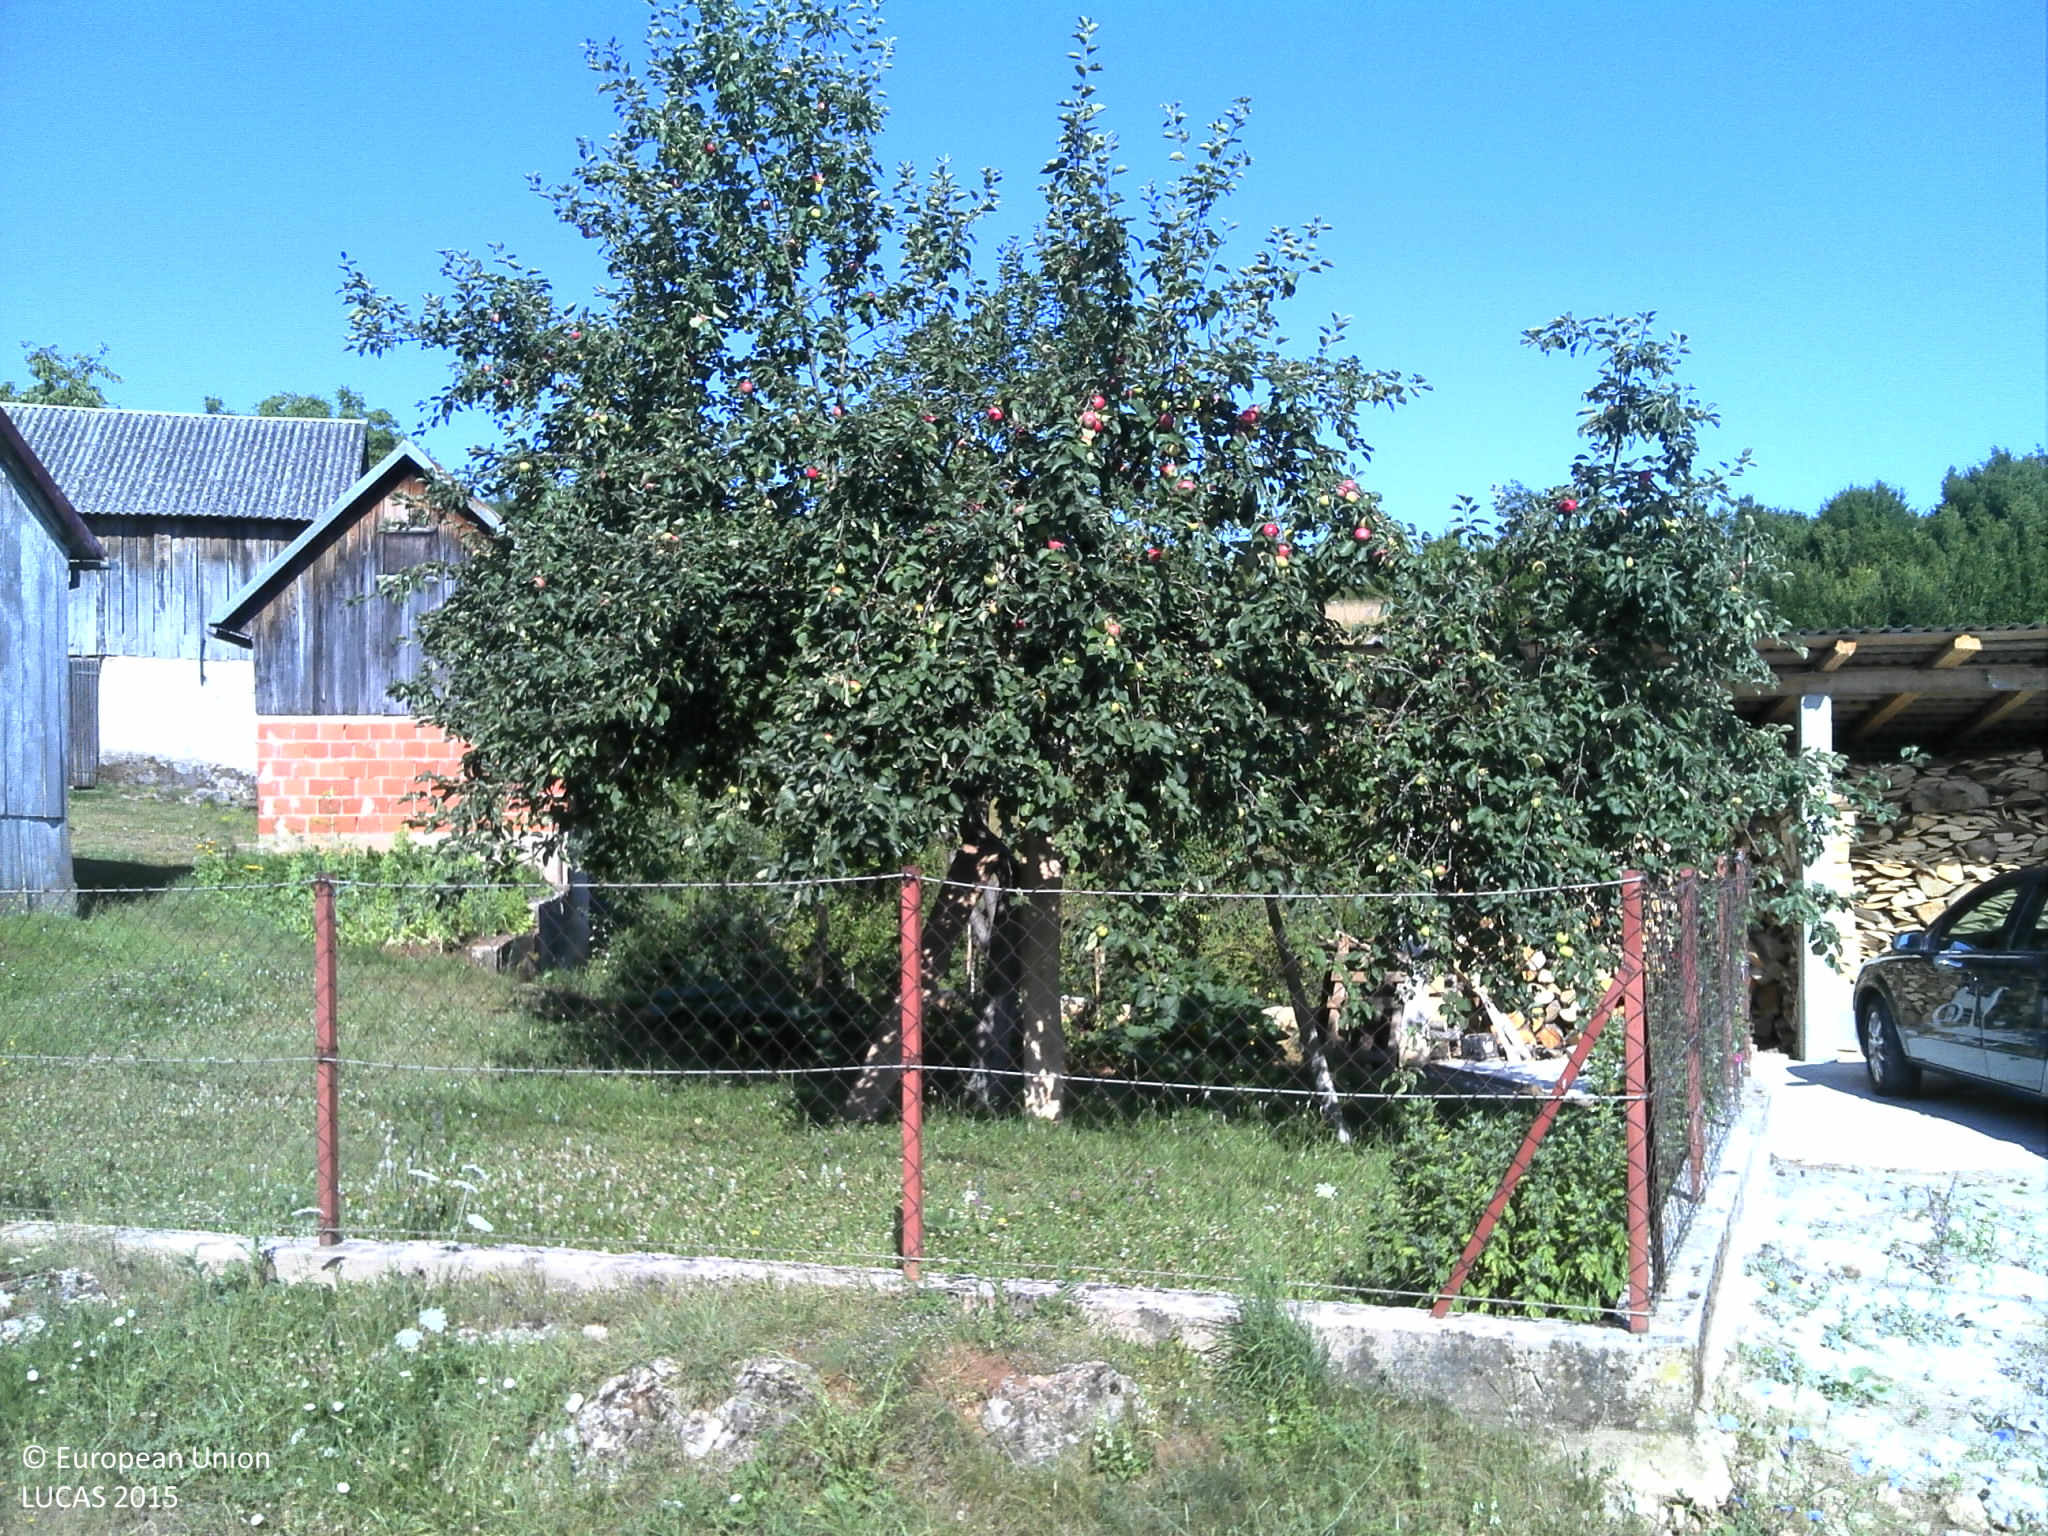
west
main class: Cropland
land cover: Other fruit trees and berries
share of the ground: 10 - 25 %
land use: Kitchen garden
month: July
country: HR
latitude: 44.8720
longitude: 15.1712
